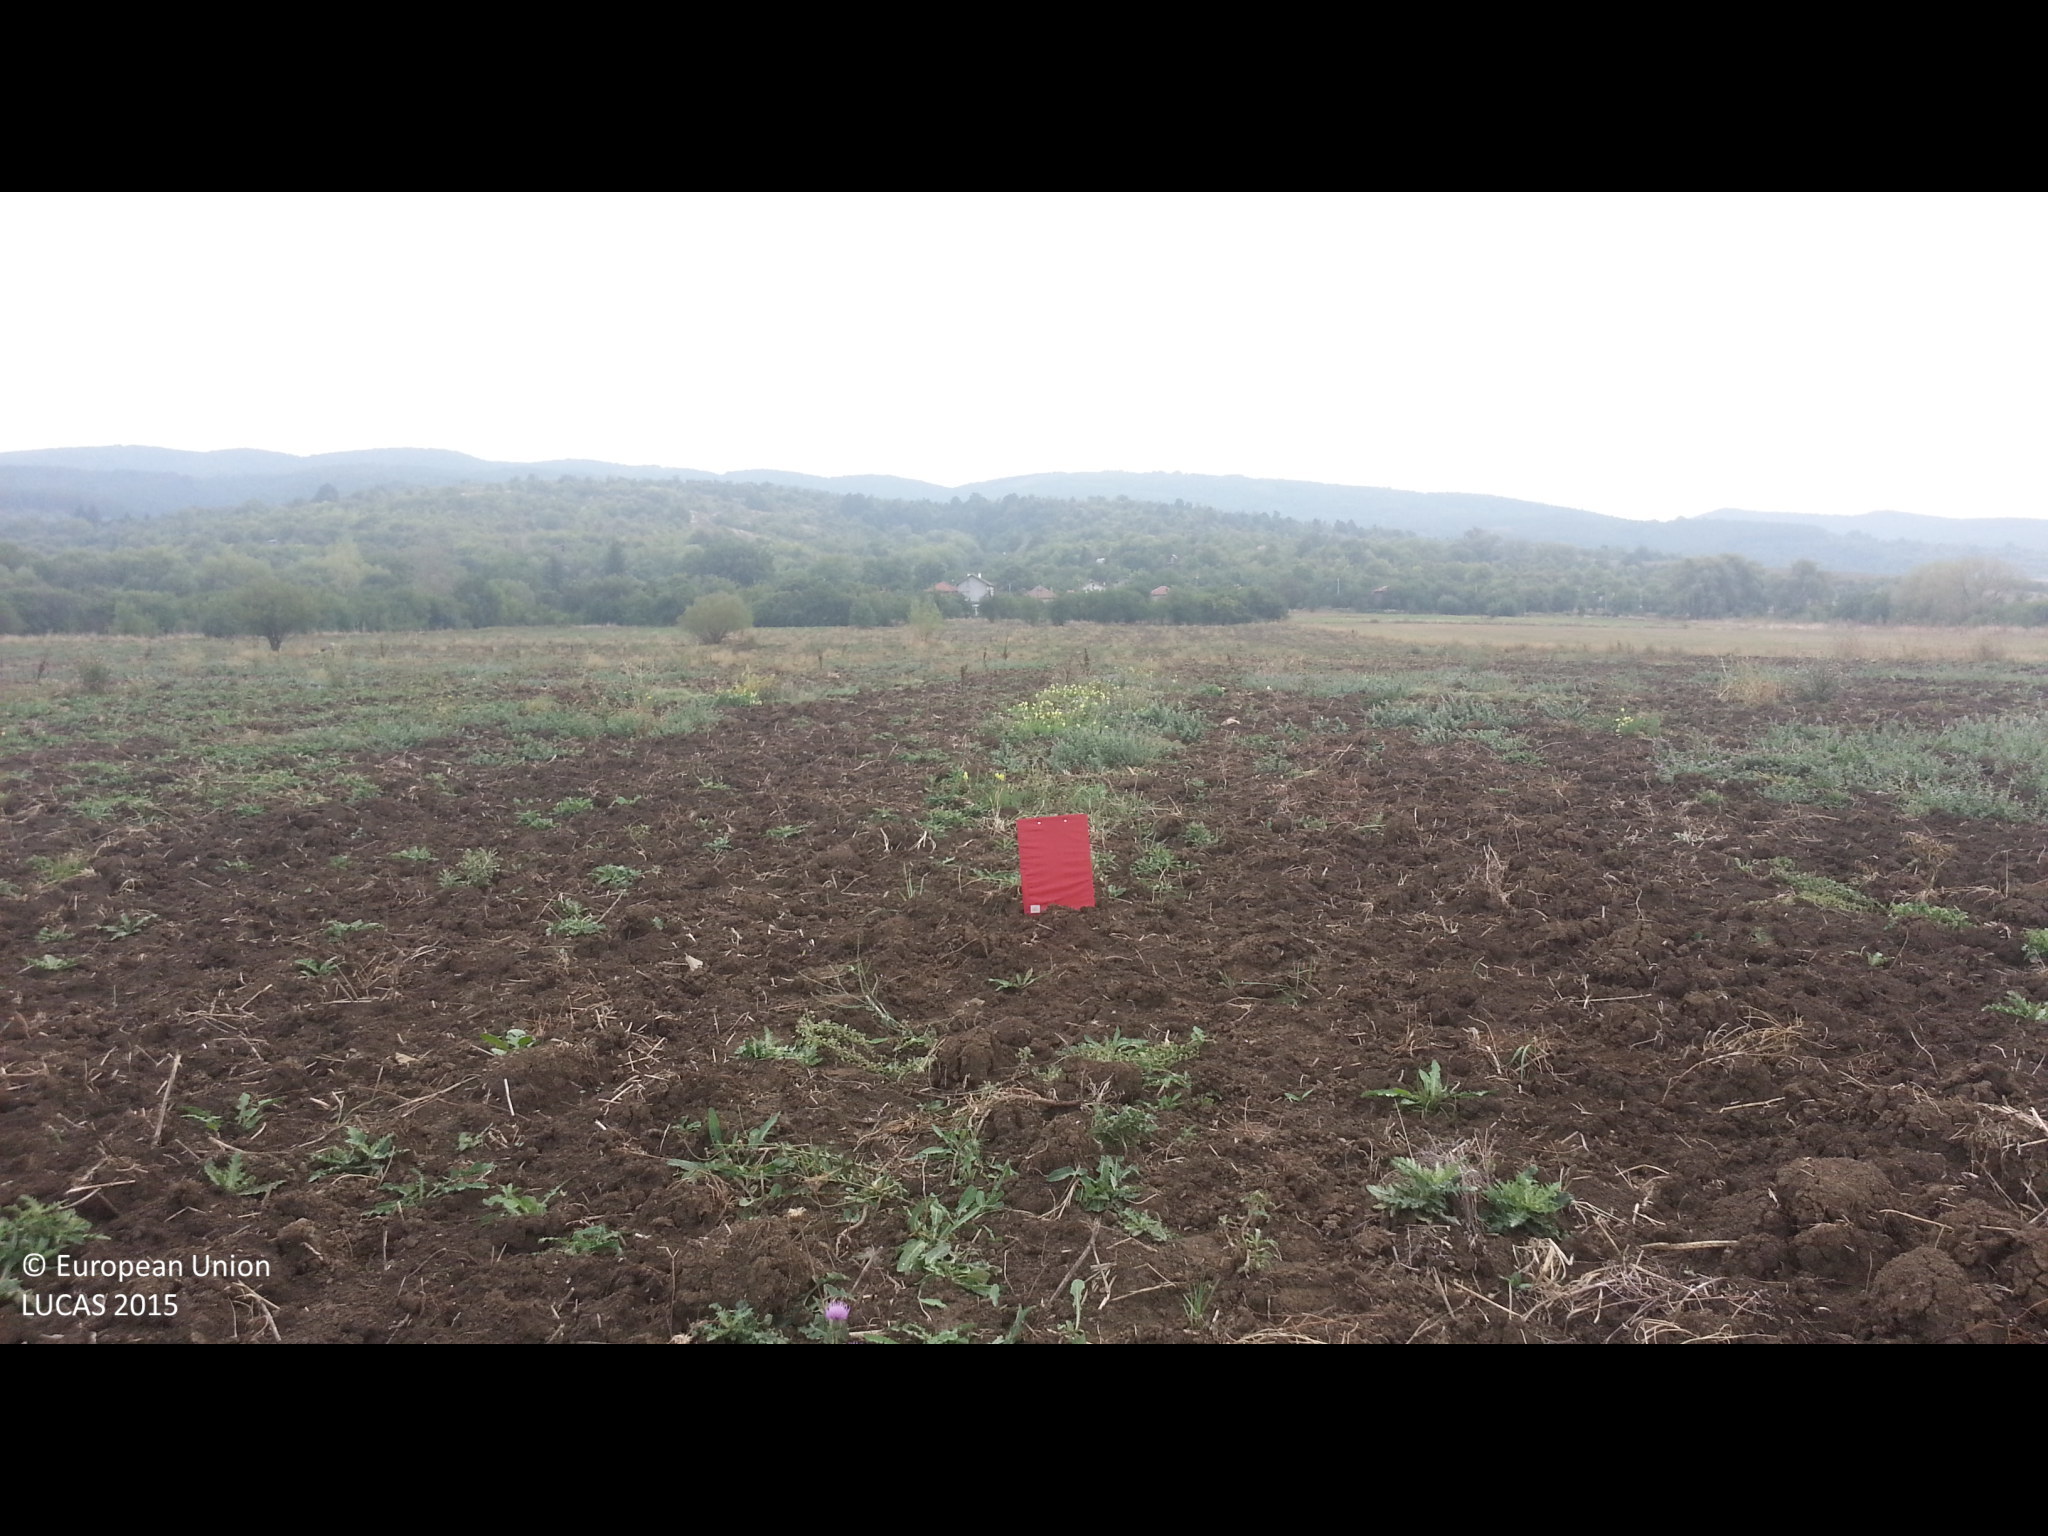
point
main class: Grassland
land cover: Spontaneously vegetated surfaces
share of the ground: 25 - 50 %
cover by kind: herbaceous plants 100 %
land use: Agriculture (excluding fallow land and kitchen gardens)
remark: Harvested field
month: September
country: BG
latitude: 42.4337
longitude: 22.9973
